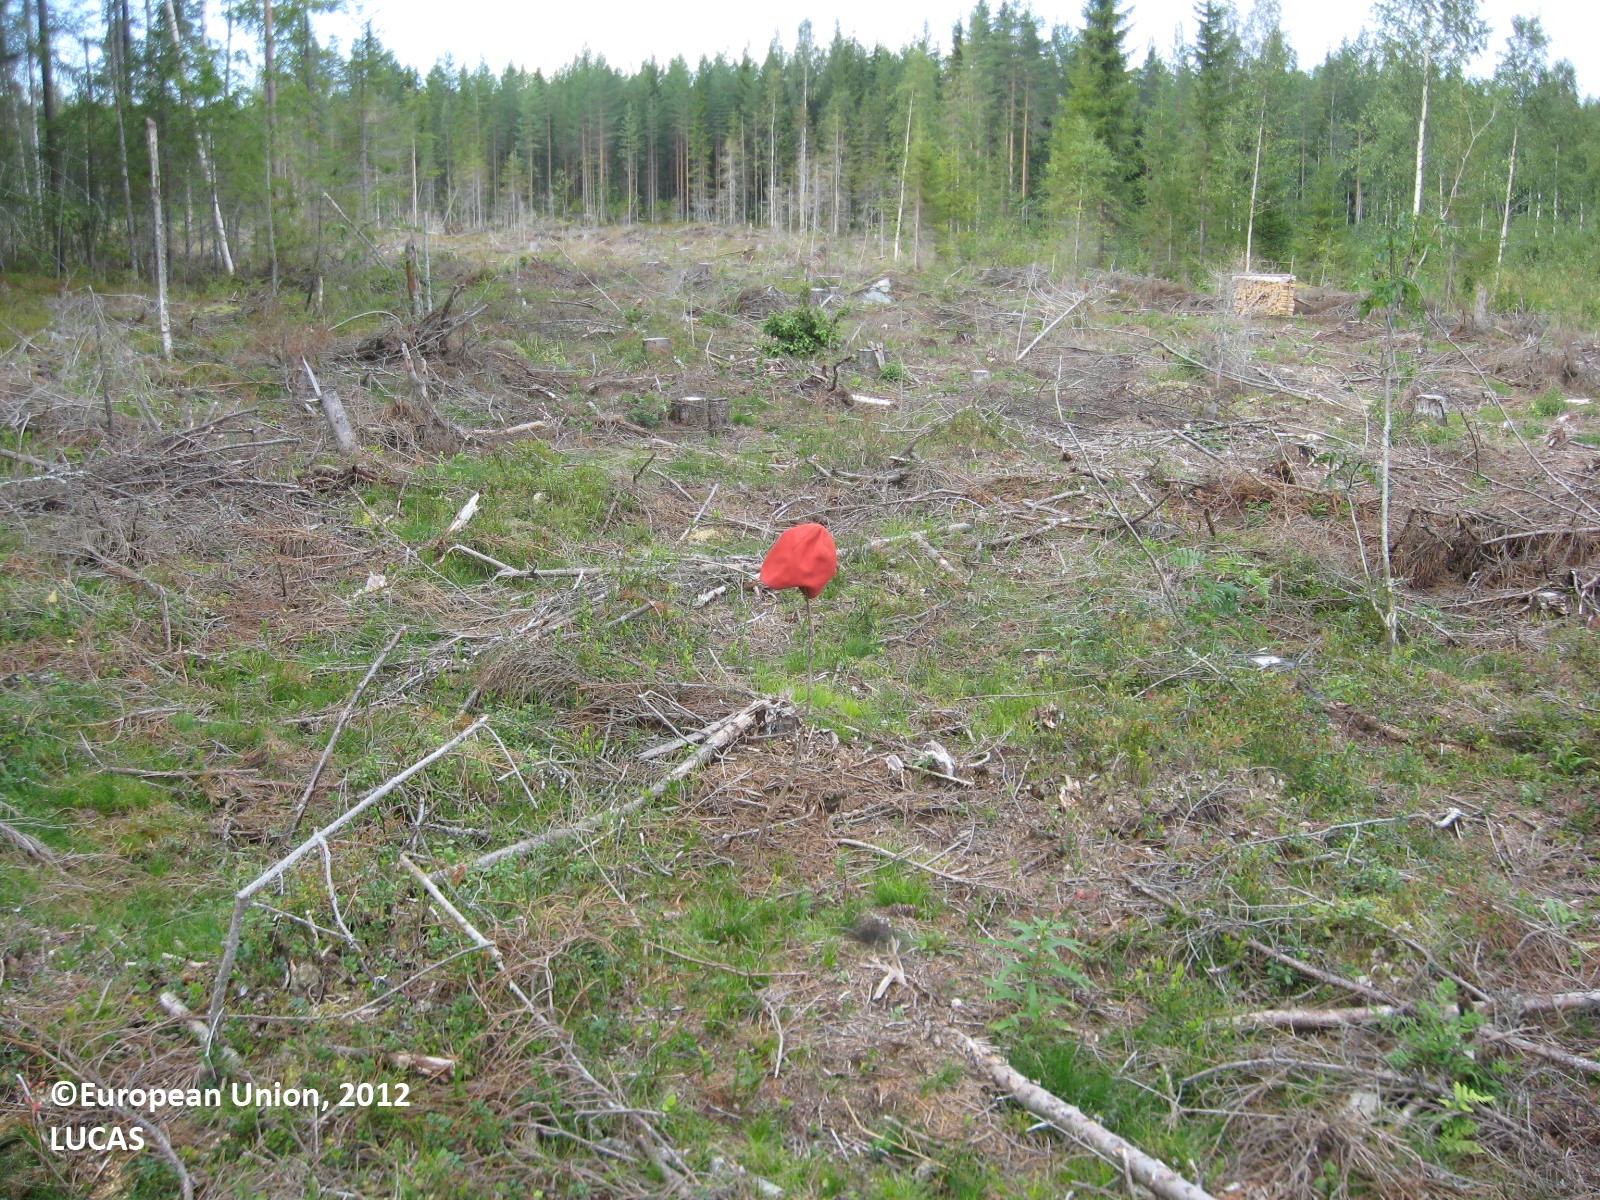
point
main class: Grassland
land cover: Grassland with sparse tree/shrub cover
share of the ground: 50 - 75 %
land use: Forestry
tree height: < 5 m
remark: Clear cut
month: August
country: FI
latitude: 63.3380
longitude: 29.6301
